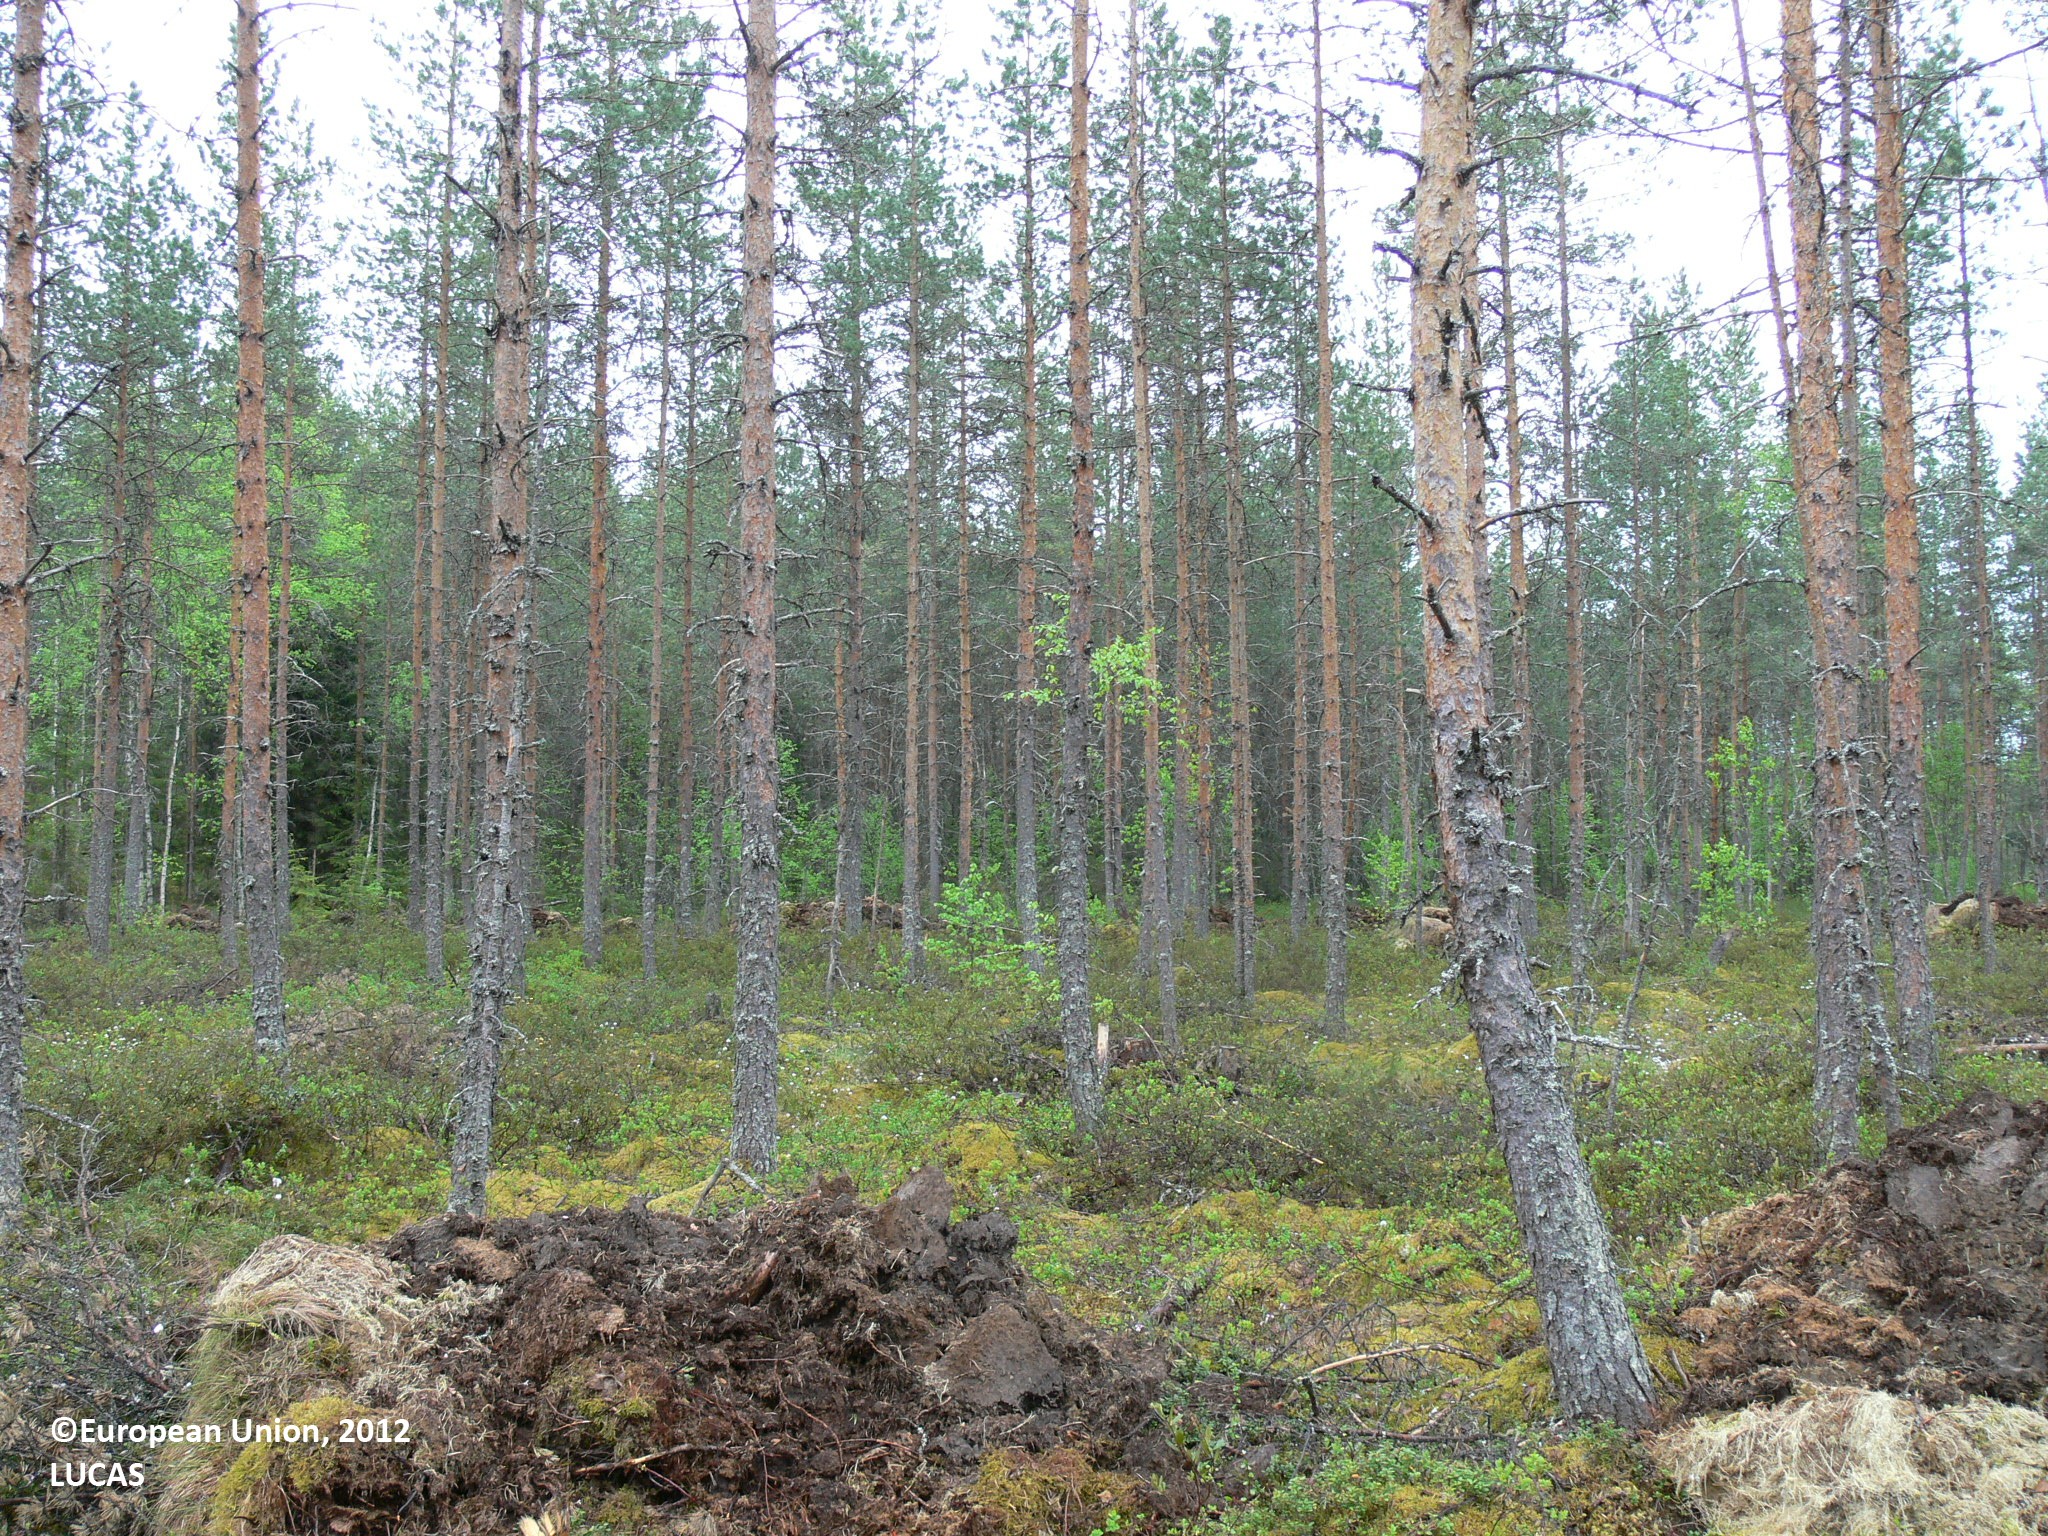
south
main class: Woodland
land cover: Pine dominated coniferous woodland
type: boreal forest
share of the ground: > 75 %
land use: Forestry
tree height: > 5 m
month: June
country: FI
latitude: 62.2268
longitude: 30.2219
